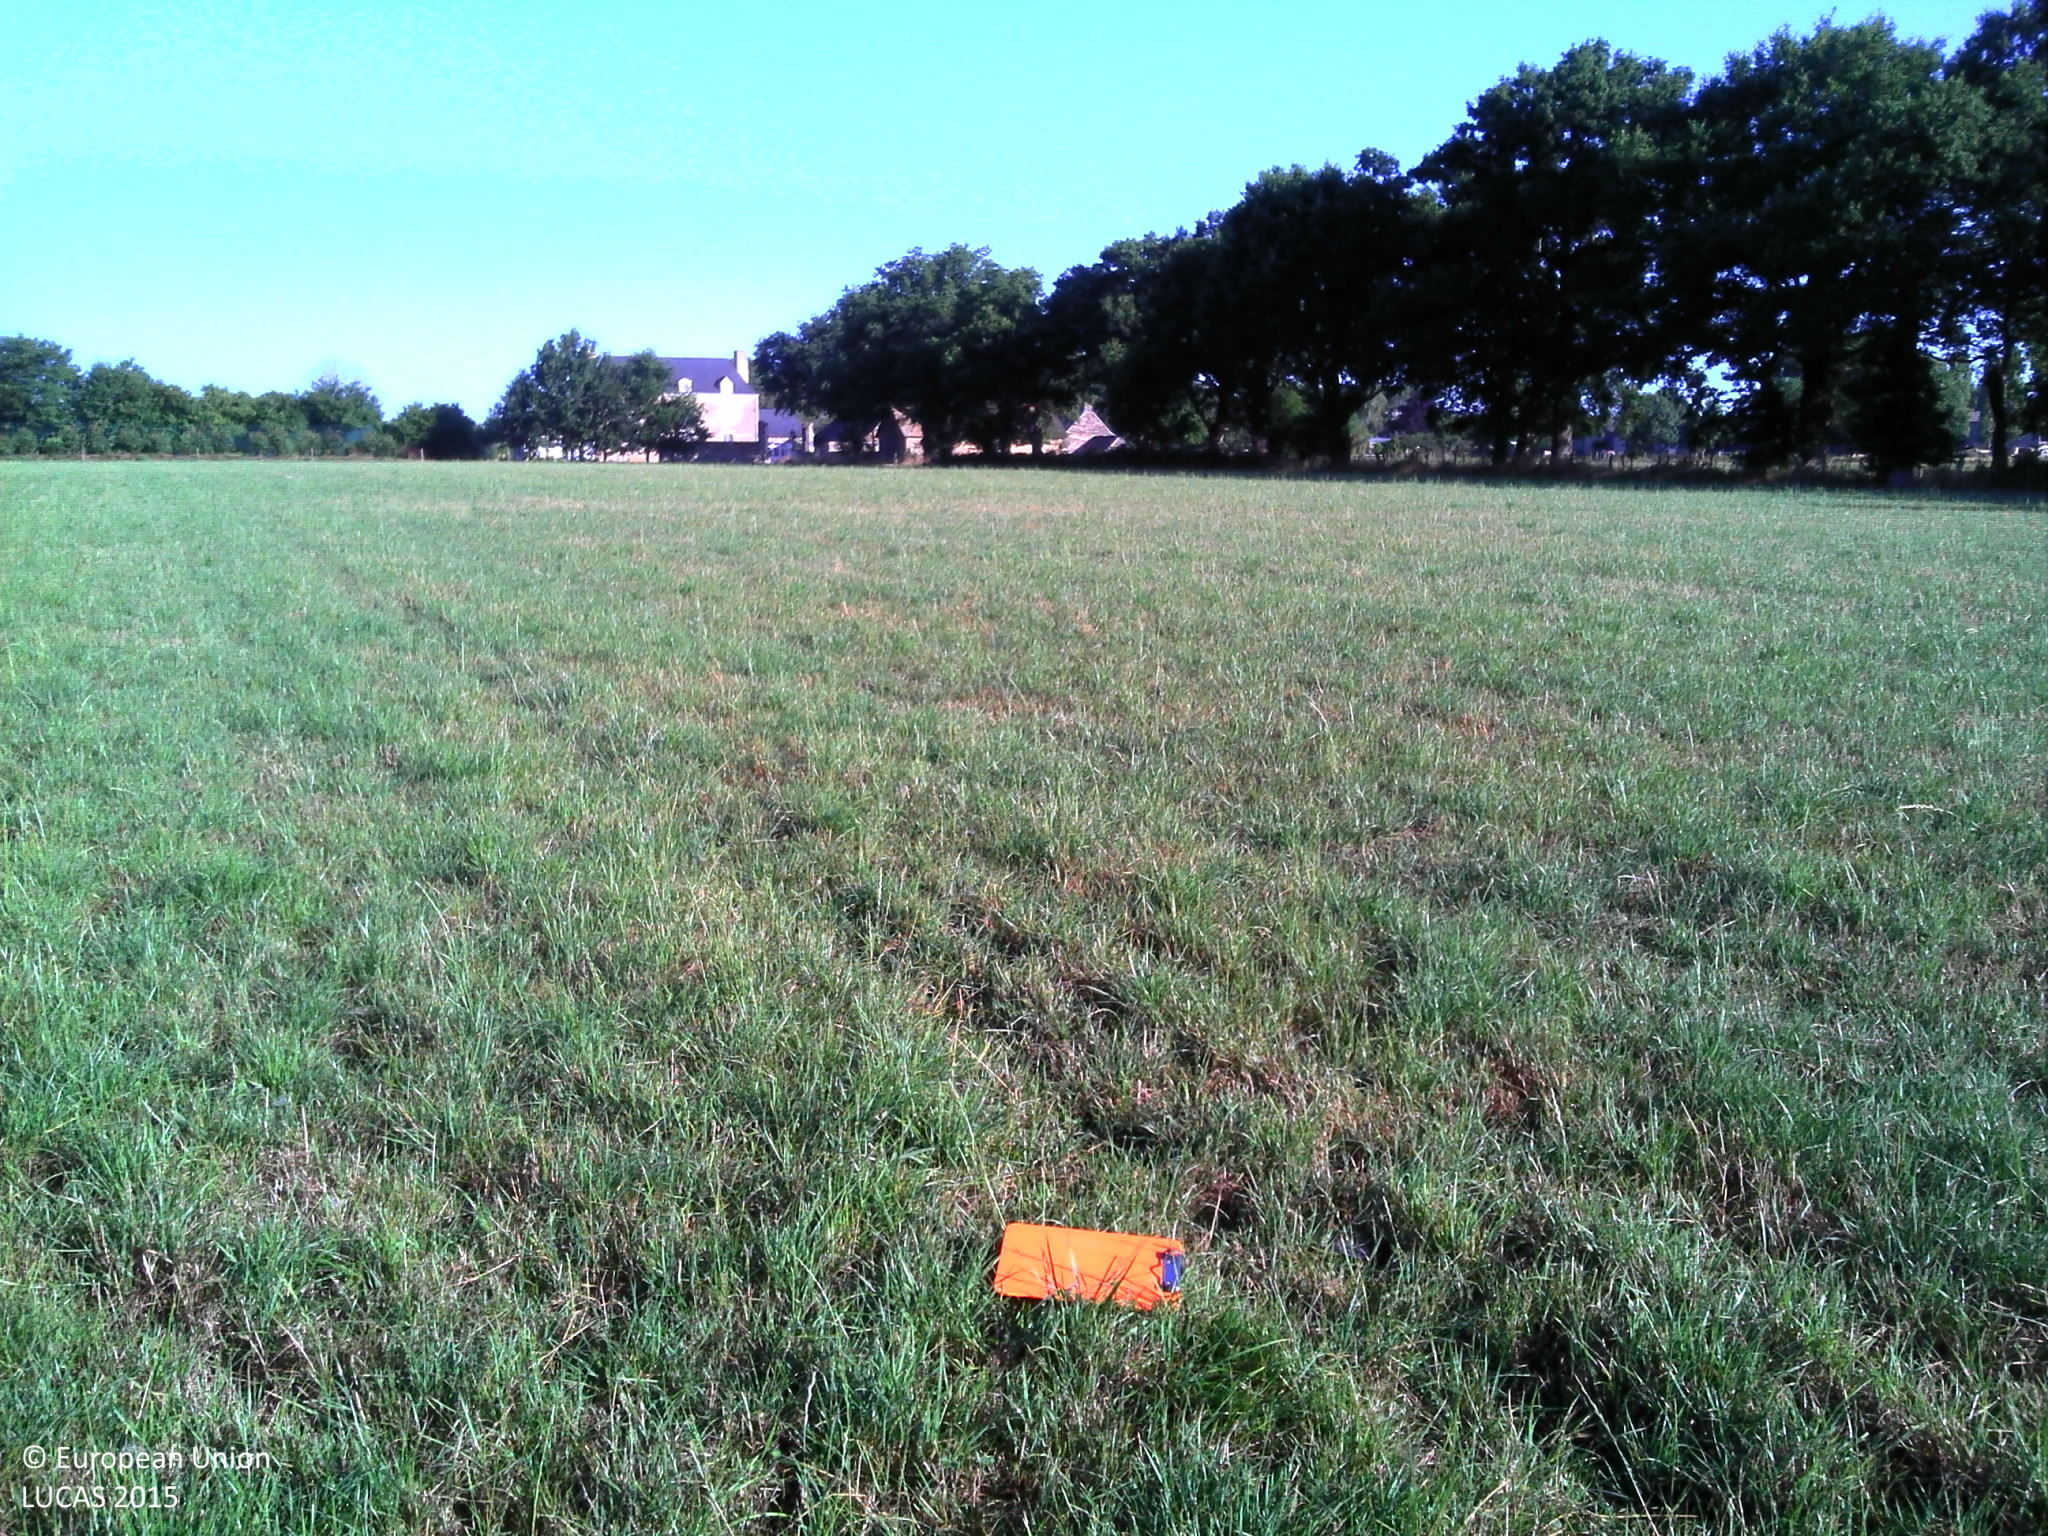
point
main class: Cropland
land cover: Temporary grasslands
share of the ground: > 75 %
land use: Agriculture (excluding fallow land and kitchen gardens)
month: July
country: FR
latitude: 47.6261
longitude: -1.6086
